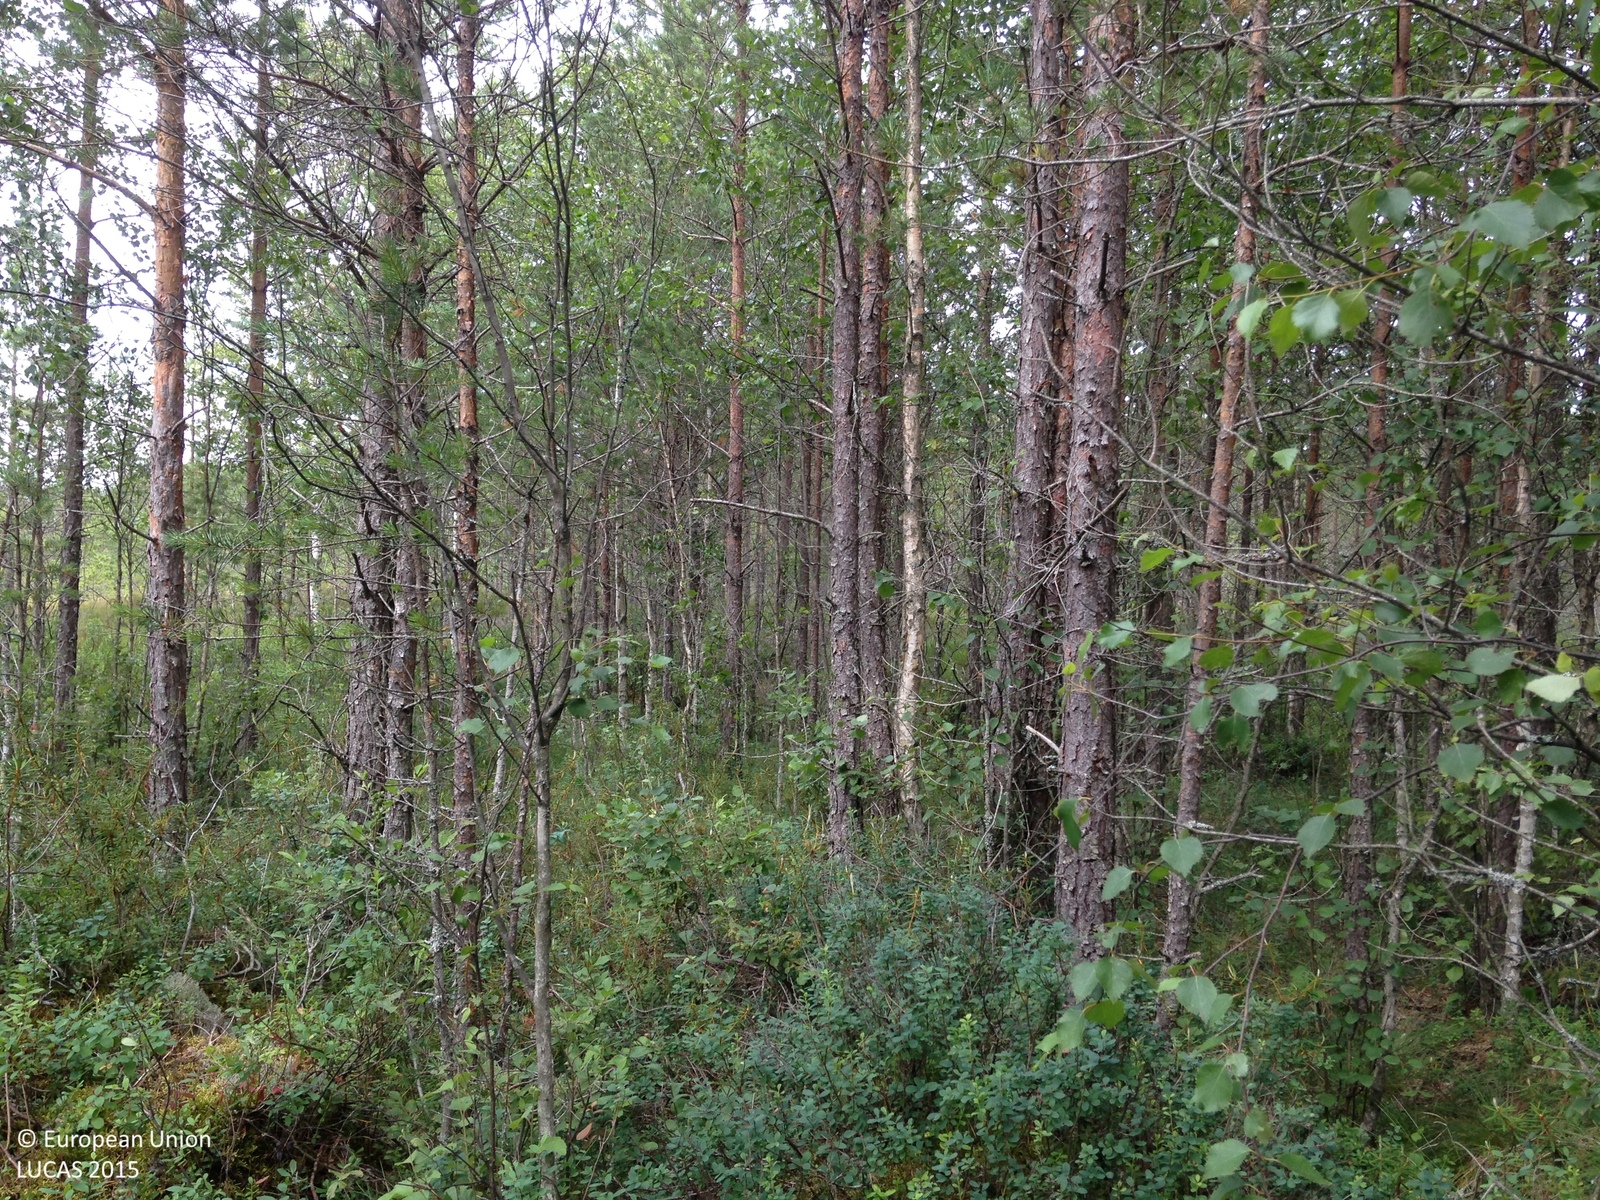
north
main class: Woodland
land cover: Pine dominated coniferous woodland
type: boreal forest
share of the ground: 50 - 75 %
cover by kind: coniferous forest trees 55 %, shrubs 25 %, herbaceous plants 10 %, broadleaved forest trees 5 %, lichens and mosses 5 %
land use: Semi-natural and natural areas not in use
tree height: < 5 m
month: July
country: SE
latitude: 58.9889
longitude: 14.5690
